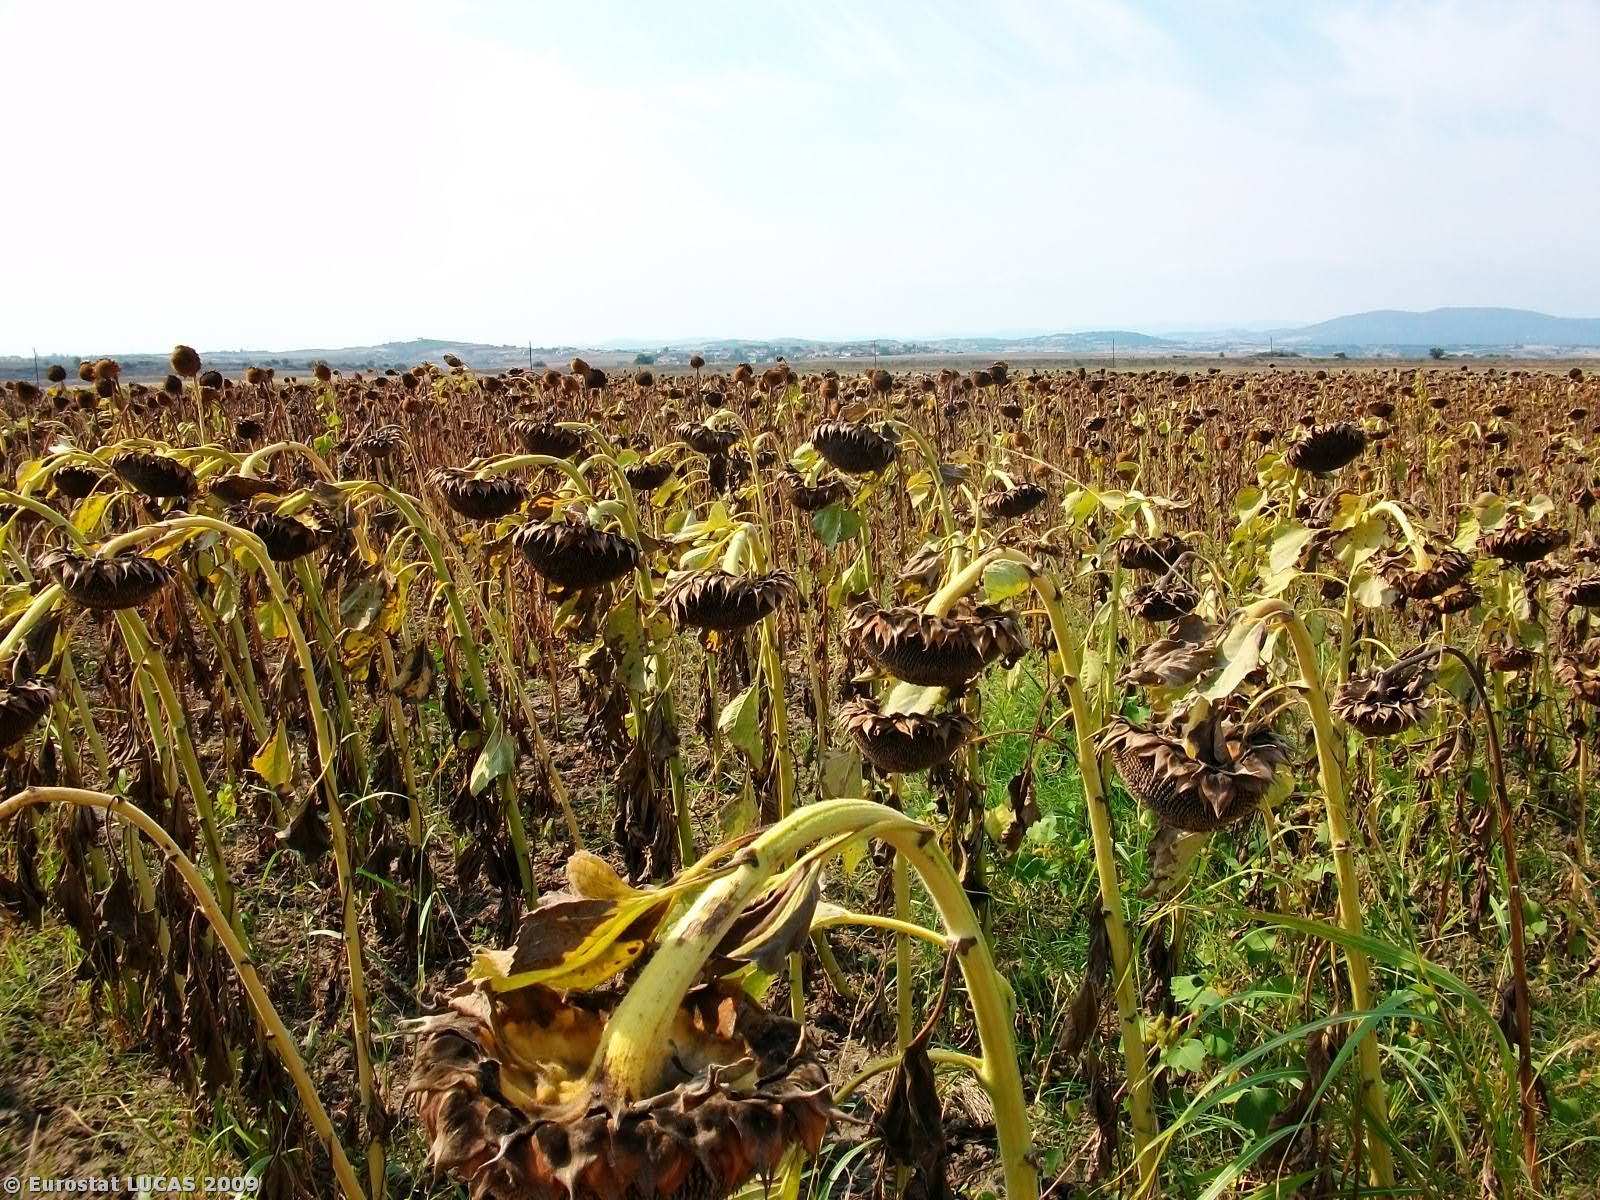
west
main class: Cropland
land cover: Sunflower
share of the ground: > 75 %
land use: Agriculture (excluding fallow land and kitchen gardens)
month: September
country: GR
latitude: 40.9933
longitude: 26.2930
